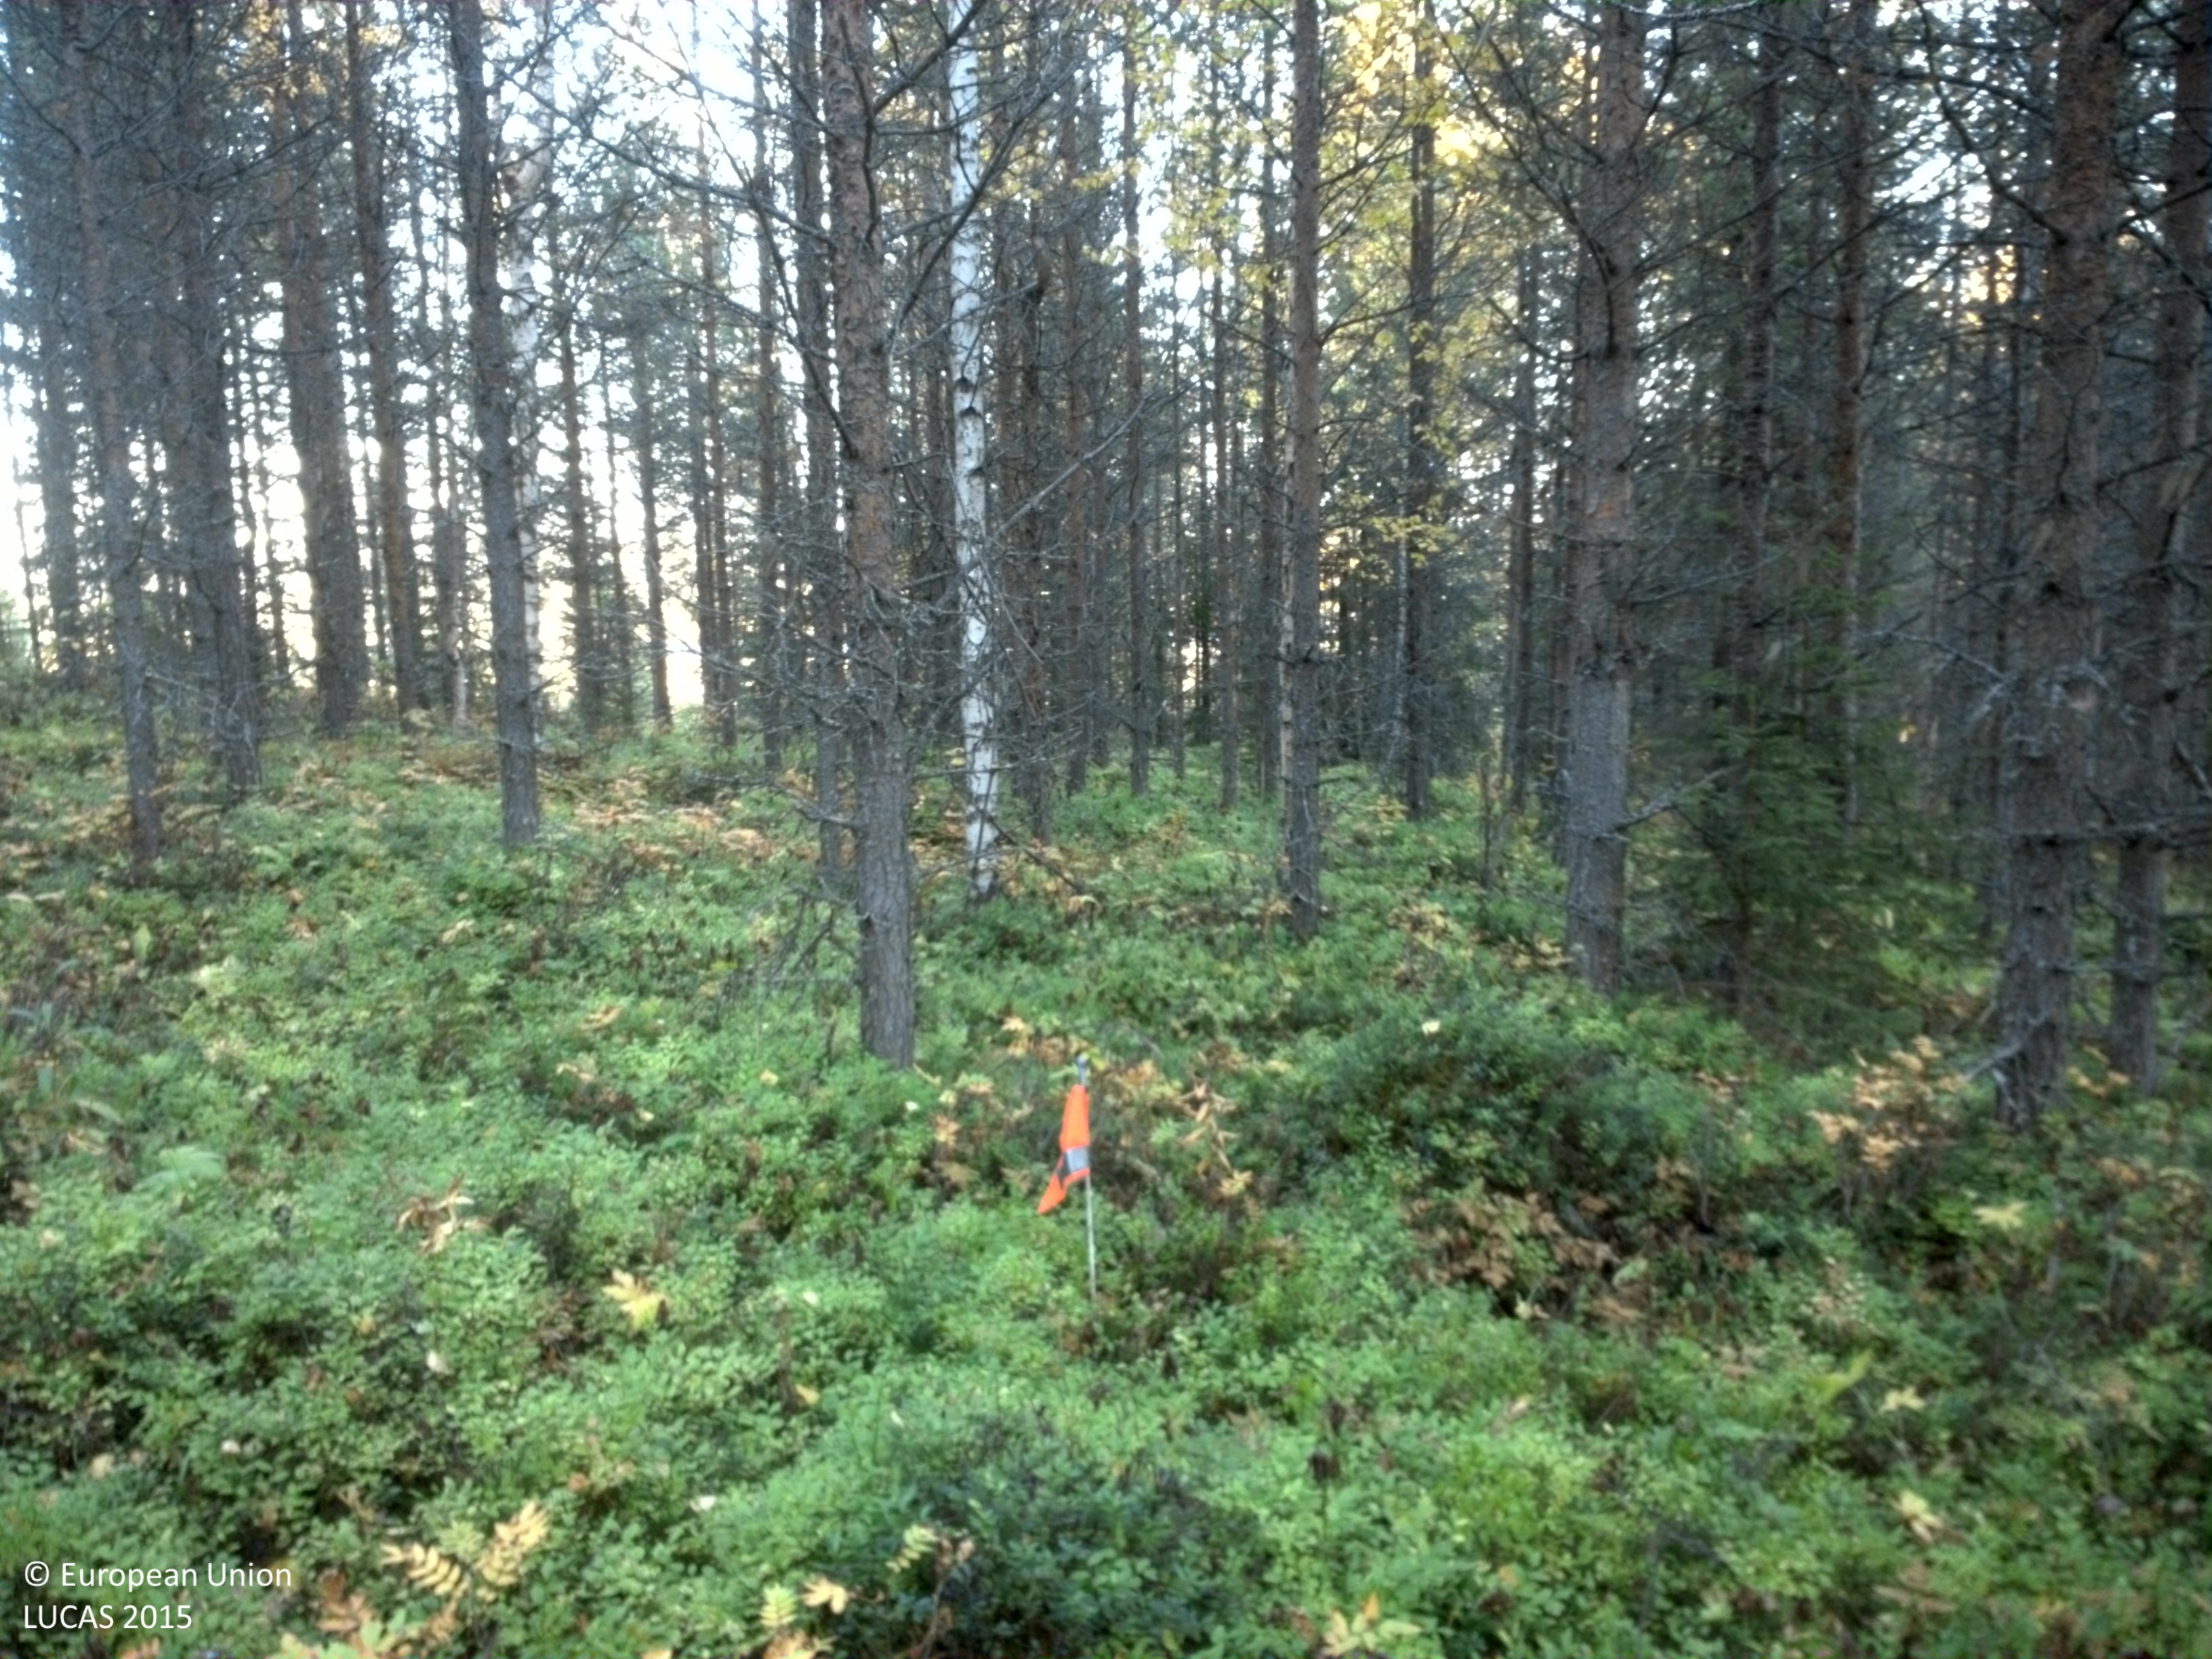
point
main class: Woodland
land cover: Pine dominated coniferous woodland
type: boreal forest
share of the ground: 50 - 75 %
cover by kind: coniferous forest trees 45 %, shrubs 35 %, broadleaved forest trees 10 %, herbaceous plants 10 %
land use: Forestry
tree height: > 5 m
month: September
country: SE
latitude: 64.9342
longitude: 17.7702
